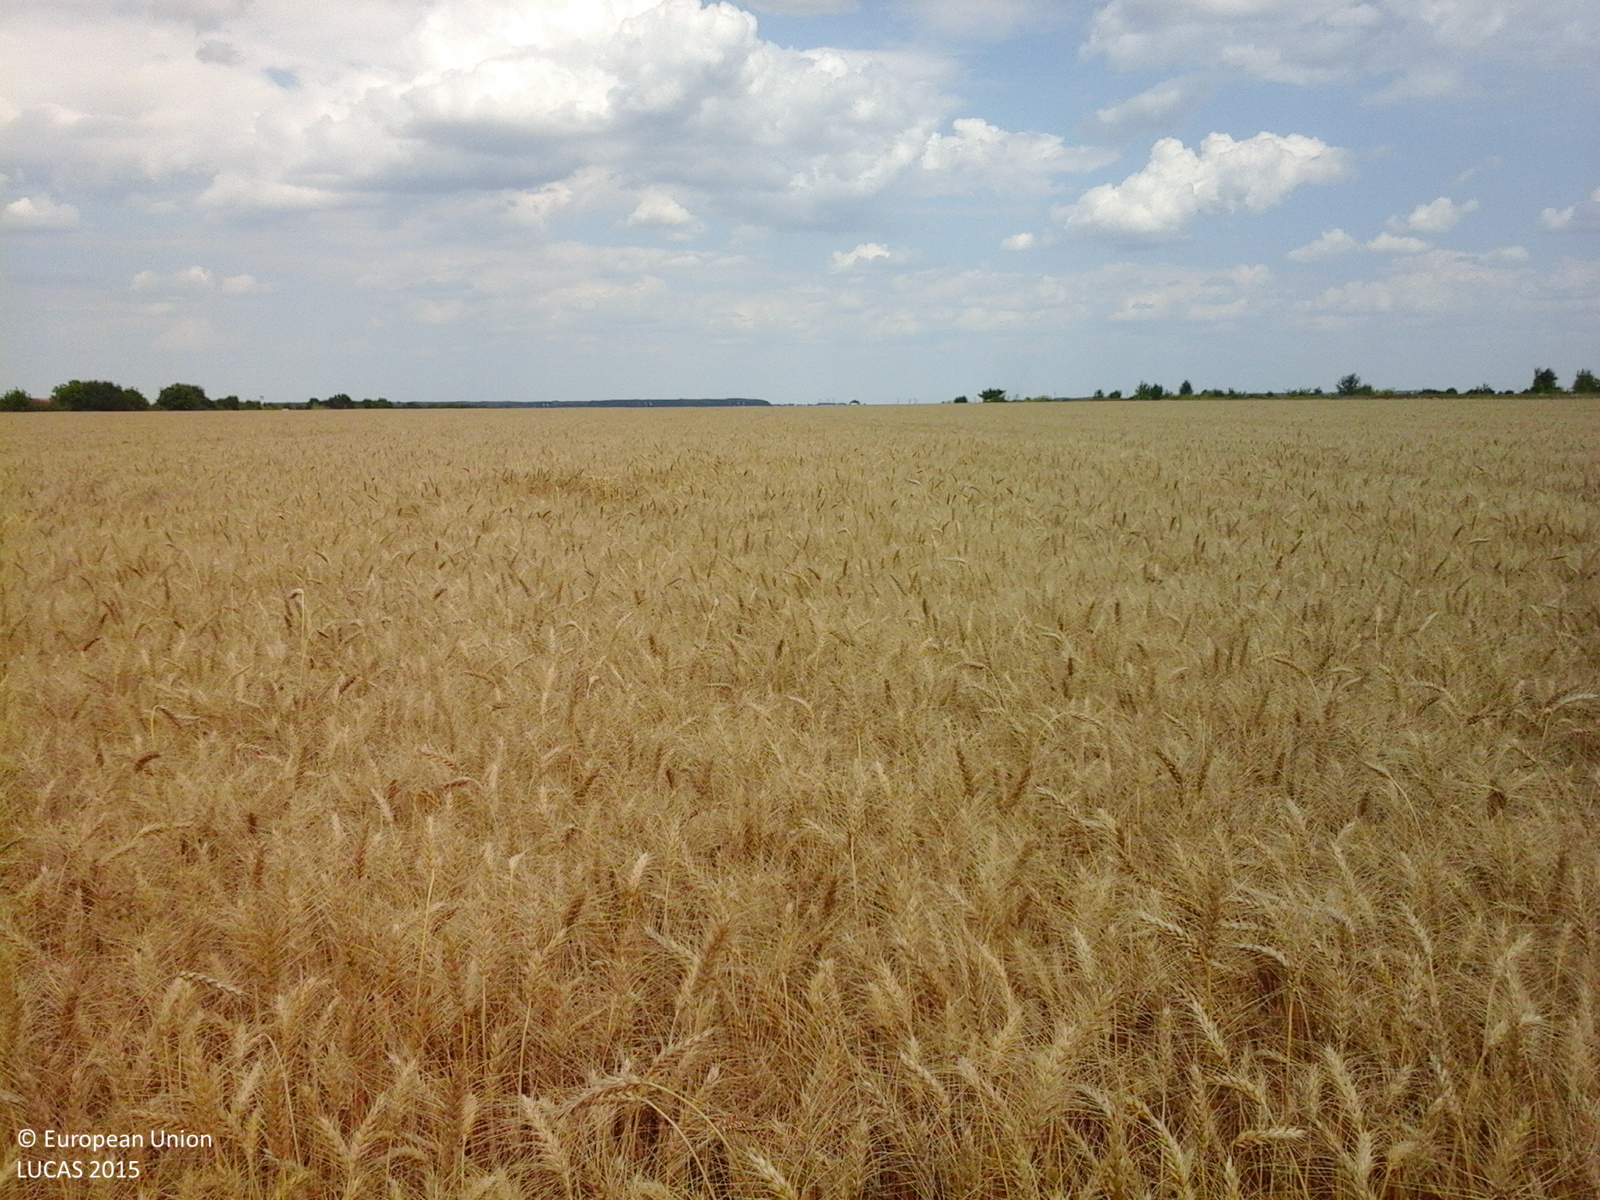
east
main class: Cropland
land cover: Common wheat
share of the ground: > 75 %
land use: Agriculture (excluding fallow land and kitchen gardens)
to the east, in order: Common wheat
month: June
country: RO
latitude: 44.5651
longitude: 26.1356
